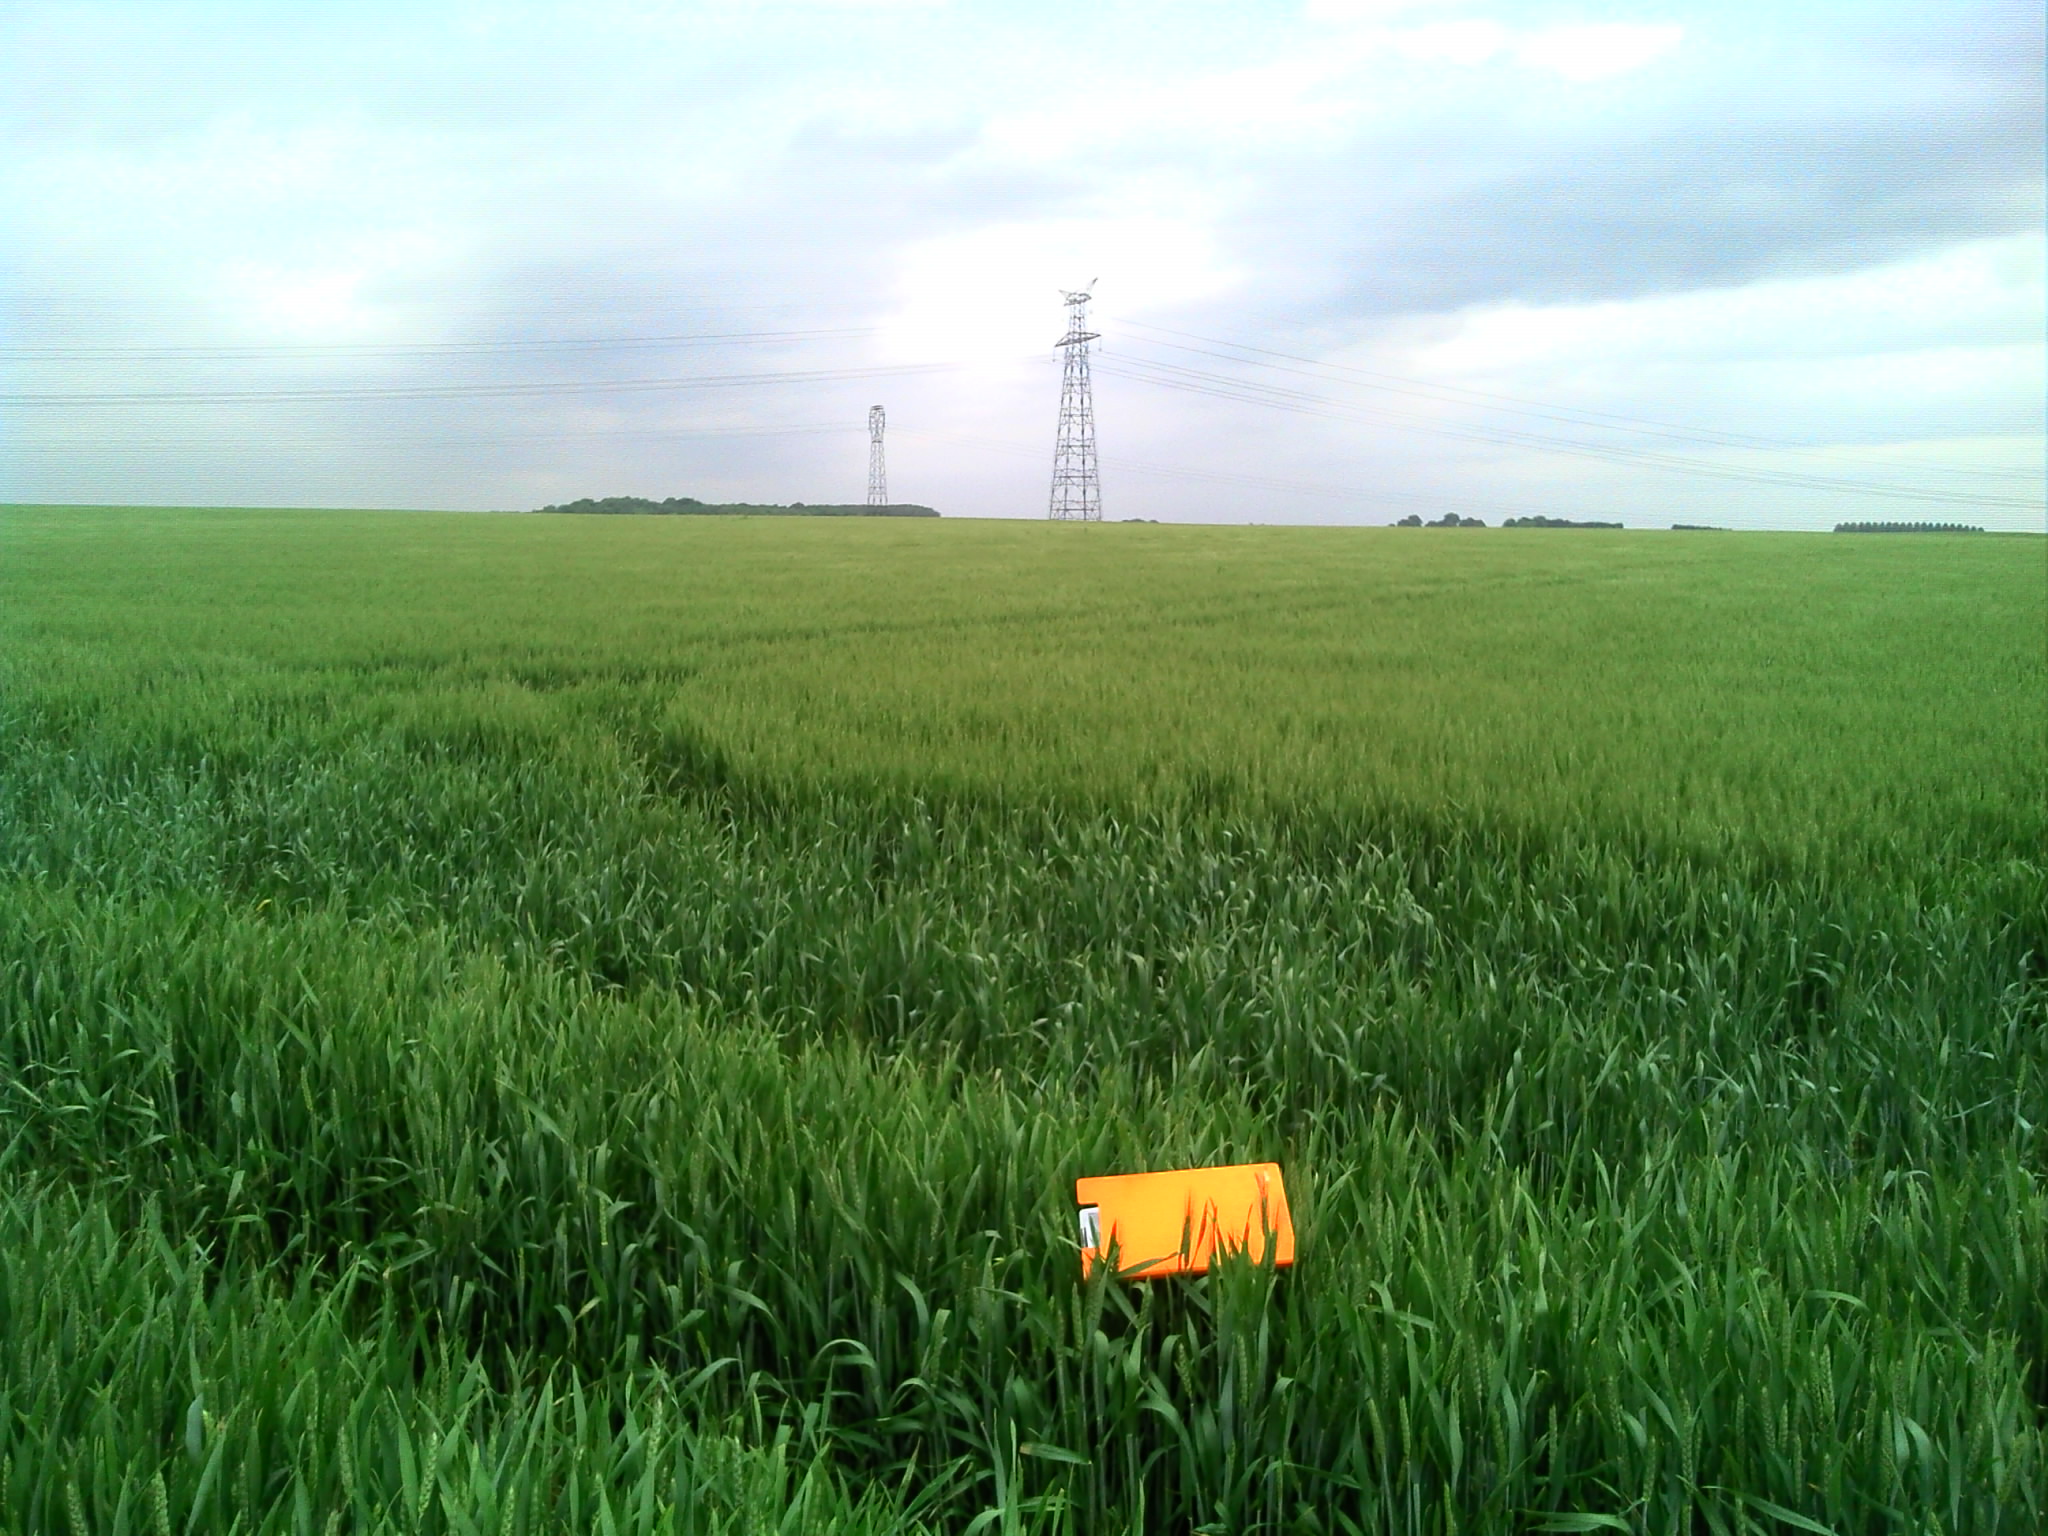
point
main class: Cropland
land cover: Common wheat
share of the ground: > 75 %
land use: Agriculture (excluding fallow land and kitchen gardens)
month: June
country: FR
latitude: 49.6395
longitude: 3.2201
